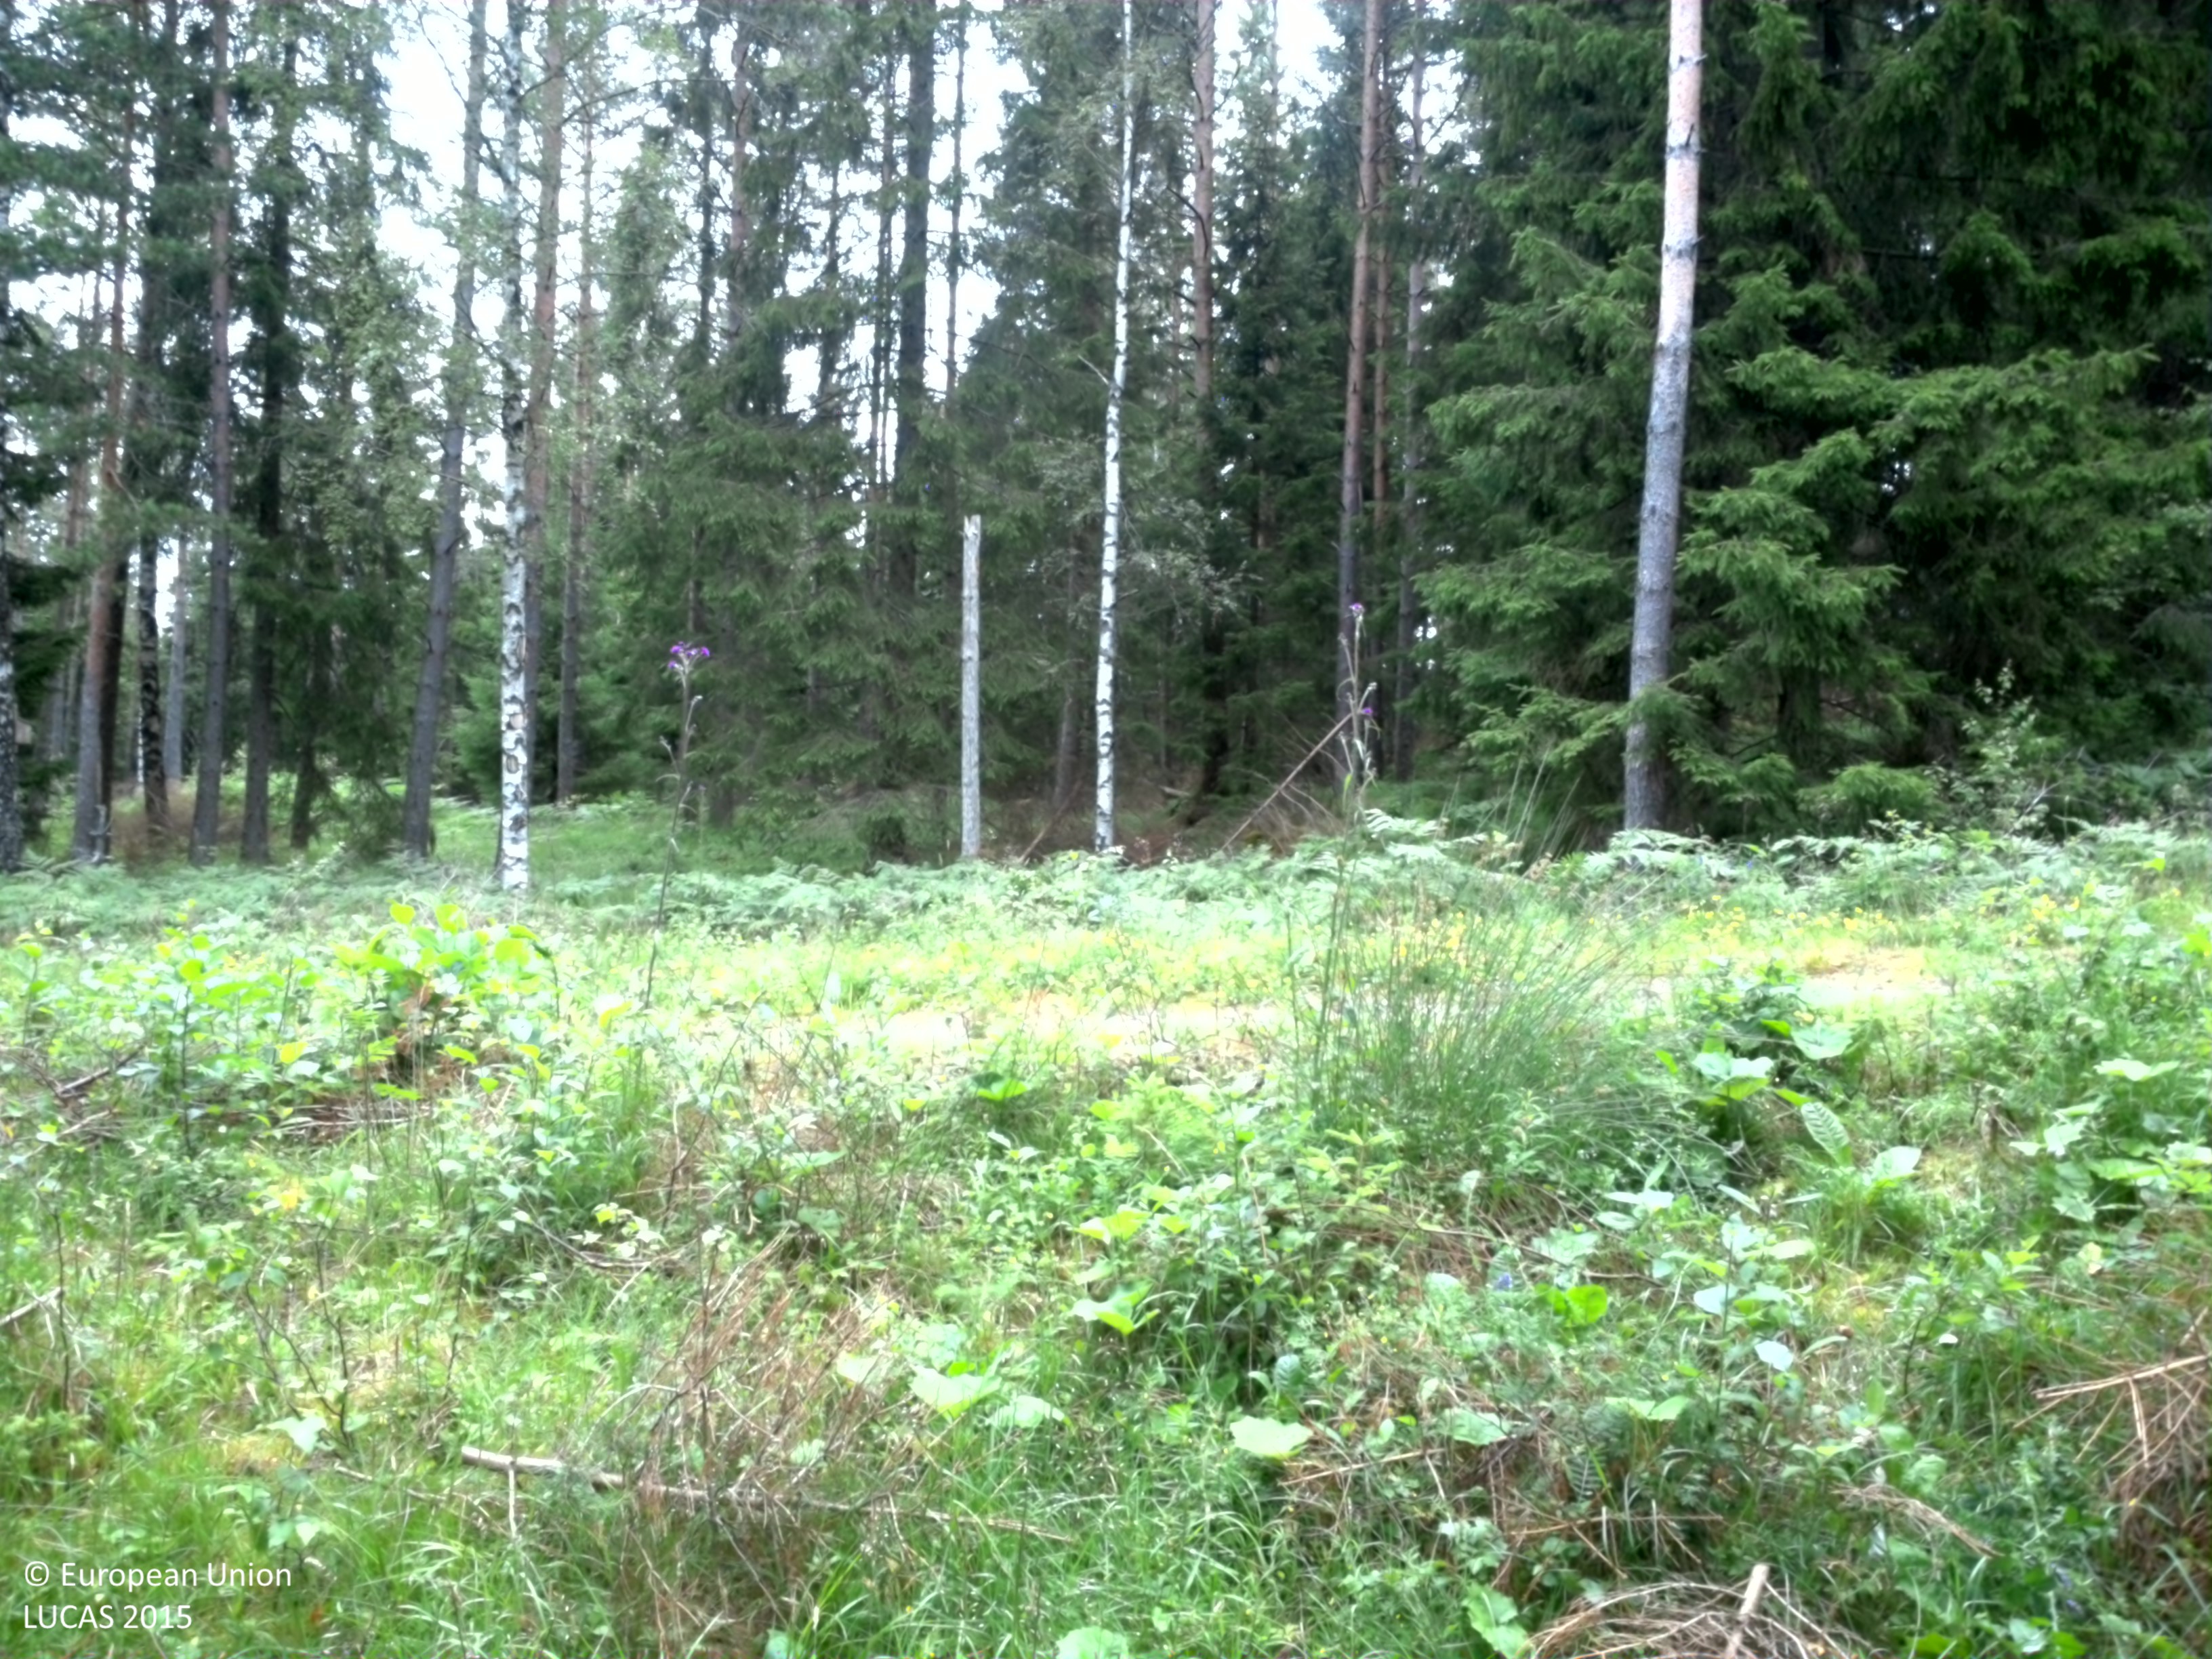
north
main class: Grassland
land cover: Grassland without tree/shrub cover
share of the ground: 50 - 75 %
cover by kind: herbaceous plants 80 %, lichens and mosses 15 %, shrubs 5 %
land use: Forestry
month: July
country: SE
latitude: 57.5523
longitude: 14.4240
